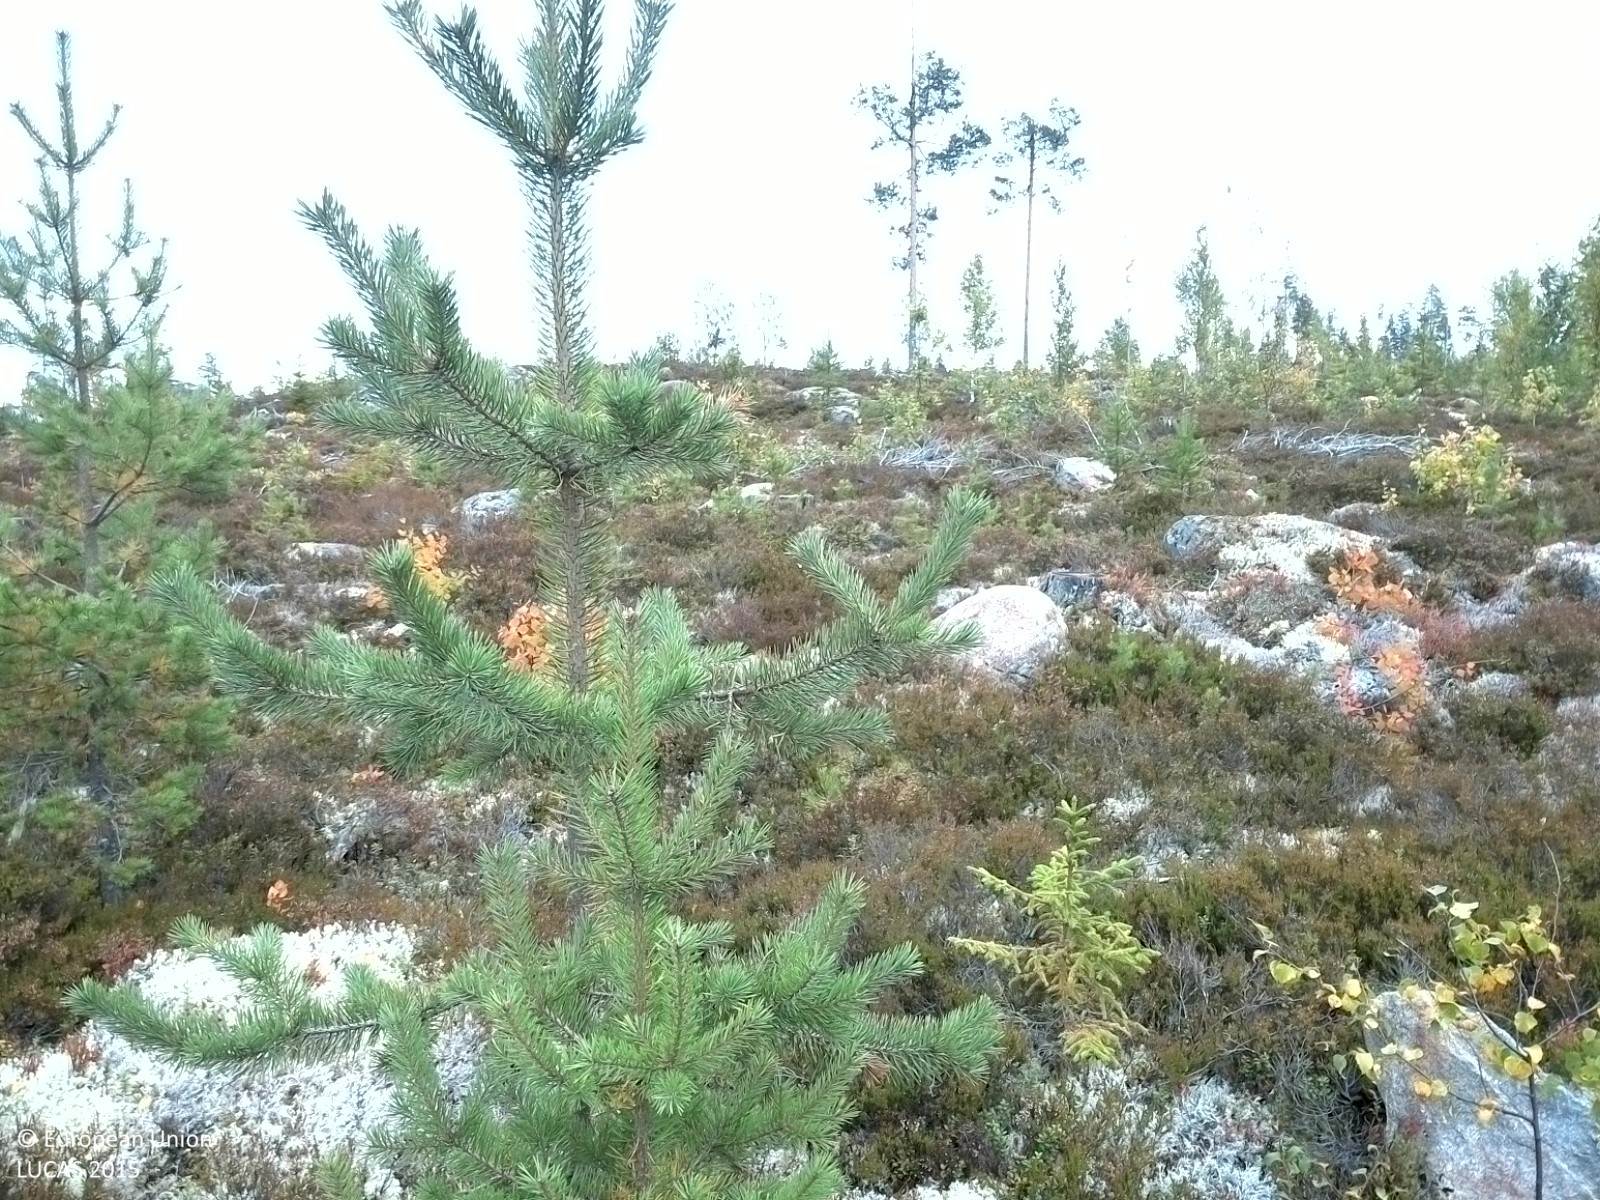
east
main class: Woodland
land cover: Other mixed woodland
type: boreal forest
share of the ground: 10 - 25 %
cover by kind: shrubs 60 %, consolidated bare surface 20 %, lichens and mosses 10 %, coniferous forest trees 5 %, broadleaved forest trees 5 %
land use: Forestry
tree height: < 5 m
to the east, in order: Other mixed woodland; Pine dominated mixed woodland
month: September
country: SE
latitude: 62.3276
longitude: 15.5971
